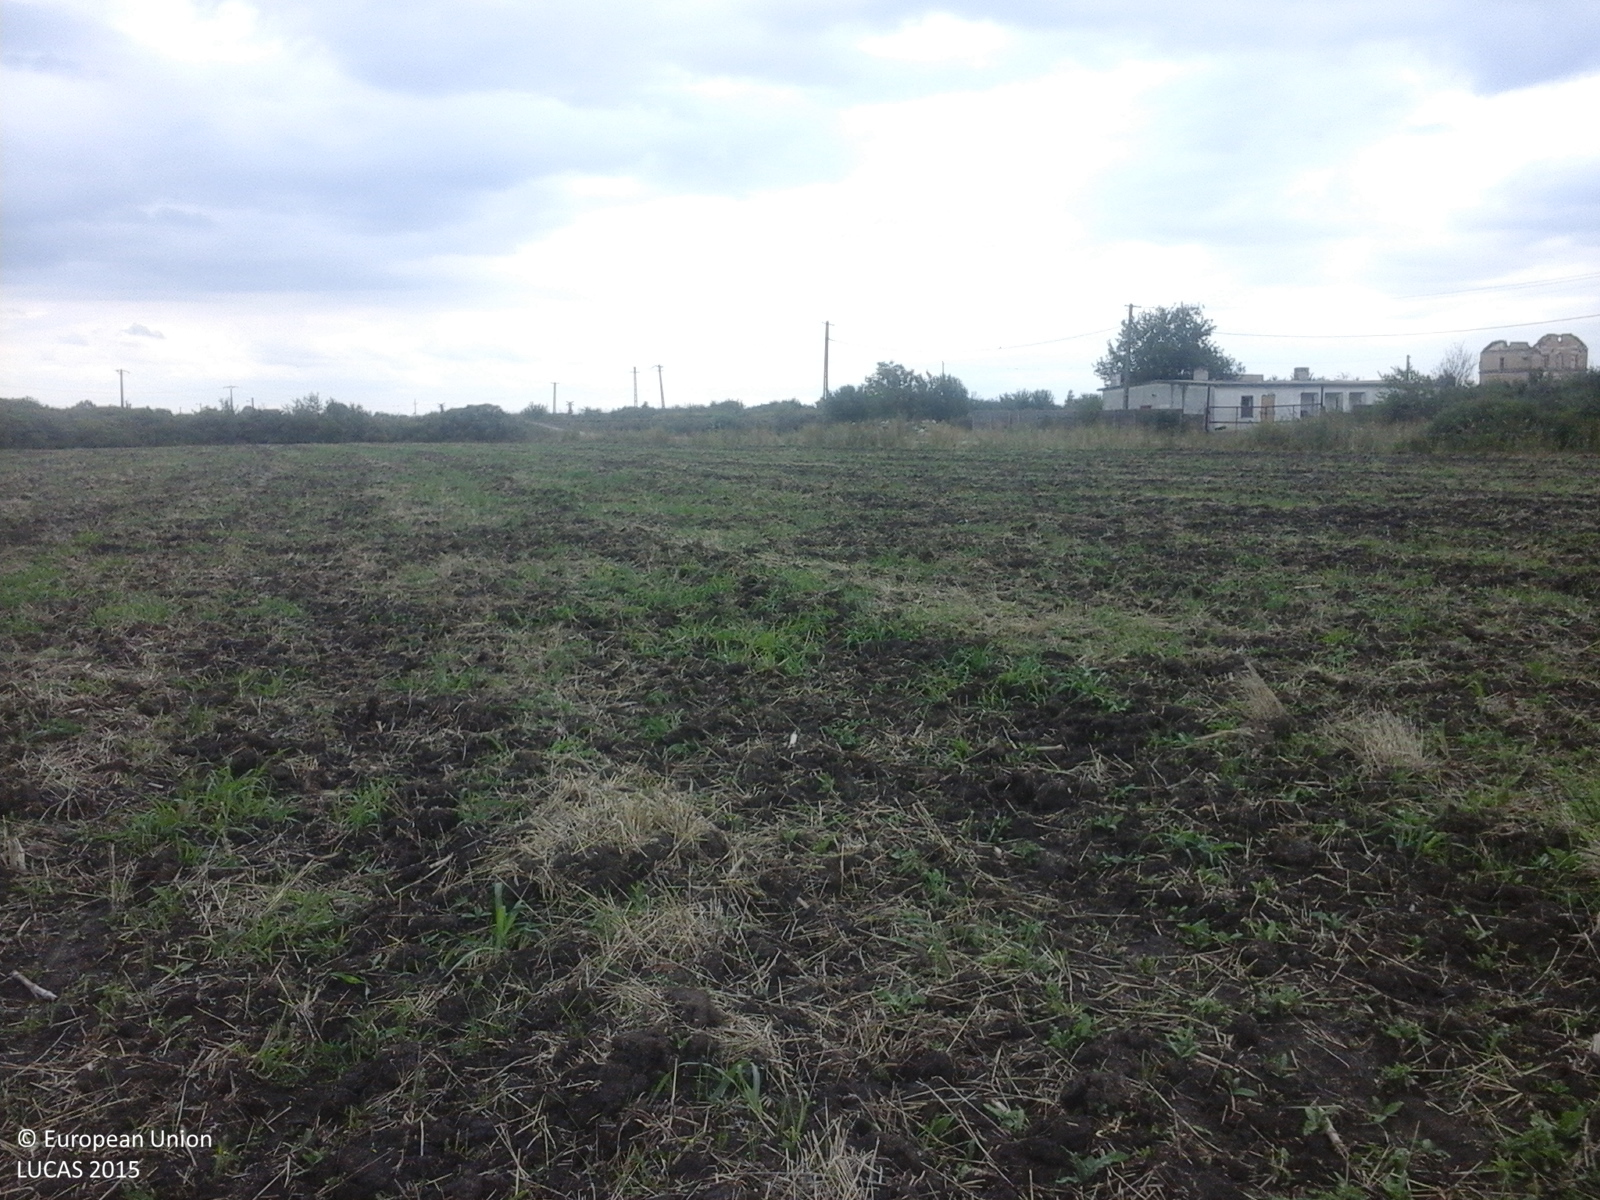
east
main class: Cropland
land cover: Common wheat
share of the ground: < 10 %
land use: Agriculture (excluding fallow land and kitchen gardens)
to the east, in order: Common wheat; Grass margins; Ditches and canals; Grass margins; Tracks; Spontaneously vegetated surfaces; Tracks; Spontaneously vegetated surfaces; Shrubland without tree cover; Grass margins; Railways; Shrubland without tree cover; Electric lines; Shrubland without tree cover; Shruby margins; Tracks; Shruby margins; Common wheat; Grass margins; Common wheat
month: August
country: RO
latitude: 45.4609
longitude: 21.1155
